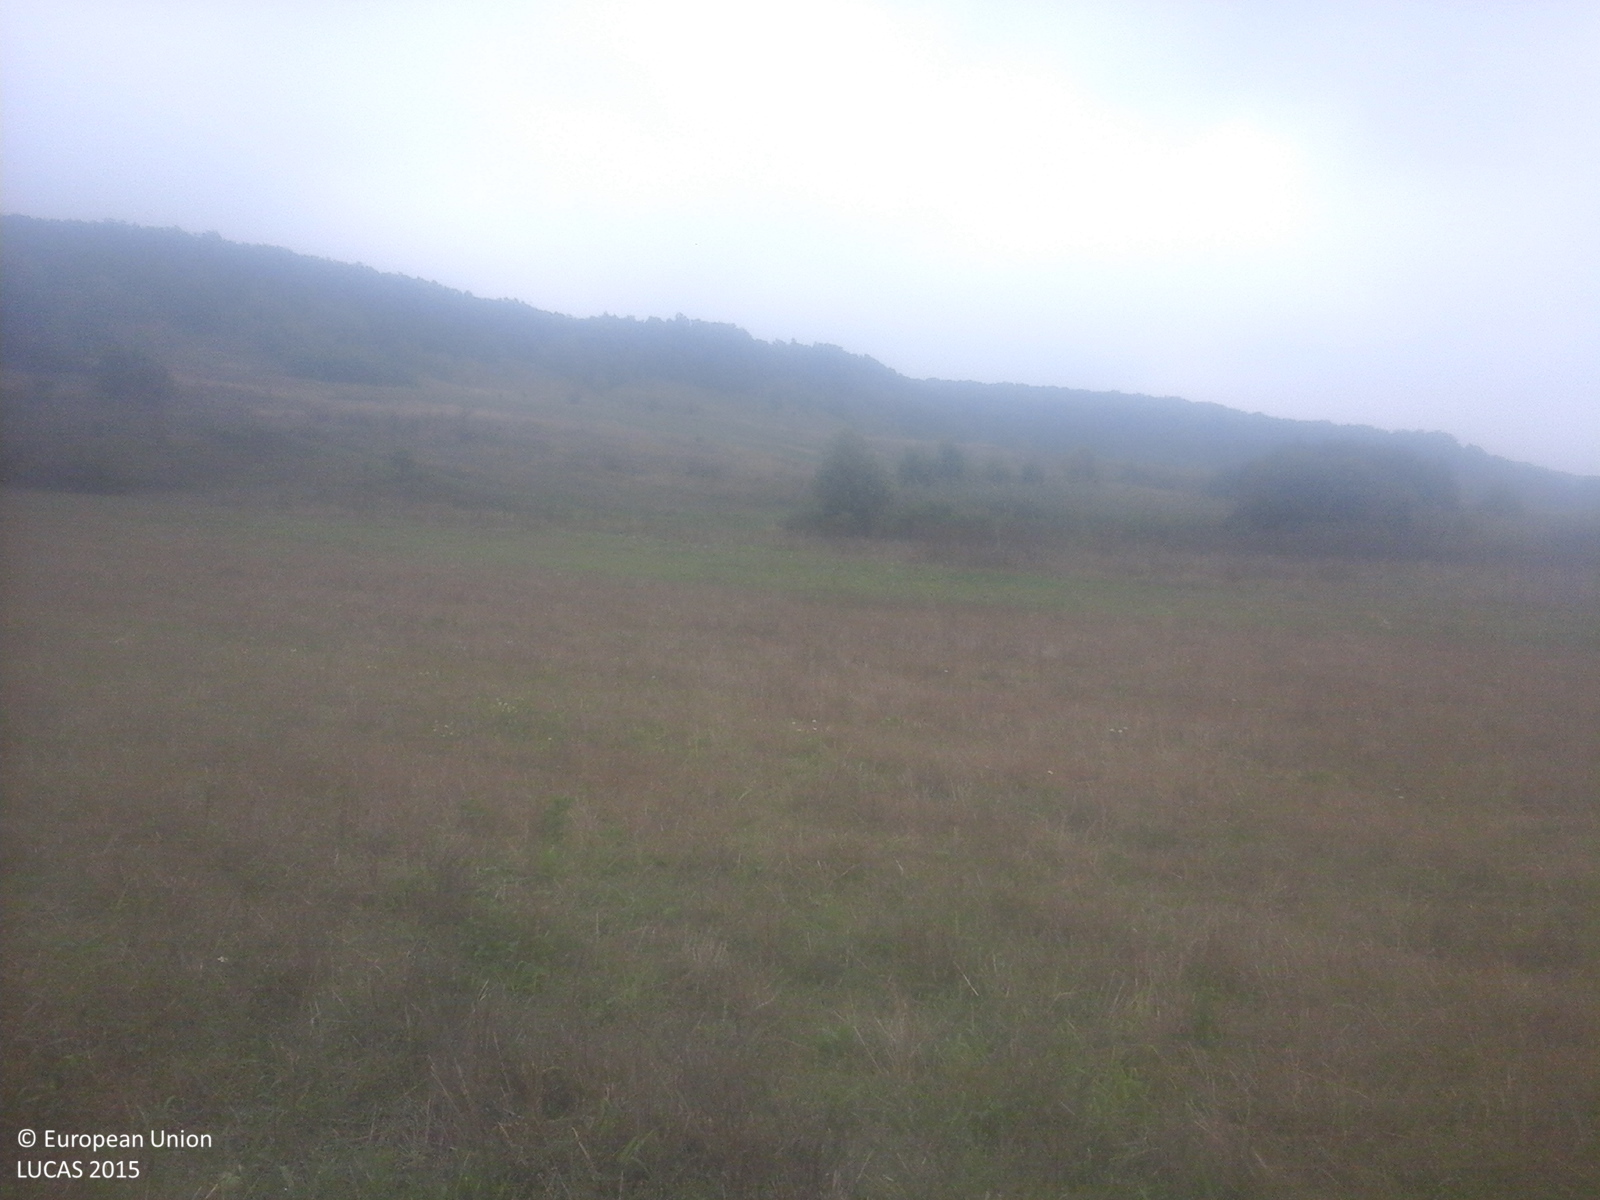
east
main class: Grassland
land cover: Spontaneously vegetated surfaces
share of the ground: > 75 %
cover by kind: herbaceous plants 100 %
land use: Fallow land
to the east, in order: Spontaneously vegetated surfaces; Tracks; Spontaneously vegetated surfaces; Grassland with sparse tree/shrub cover; Spontaneously vegetated surfaces; Tracks; Spontaneously vegetated surfaces; Tracks; Spontaneously vegetated surfaces
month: September
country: RO
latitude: 44.7382
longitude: 23.2480
